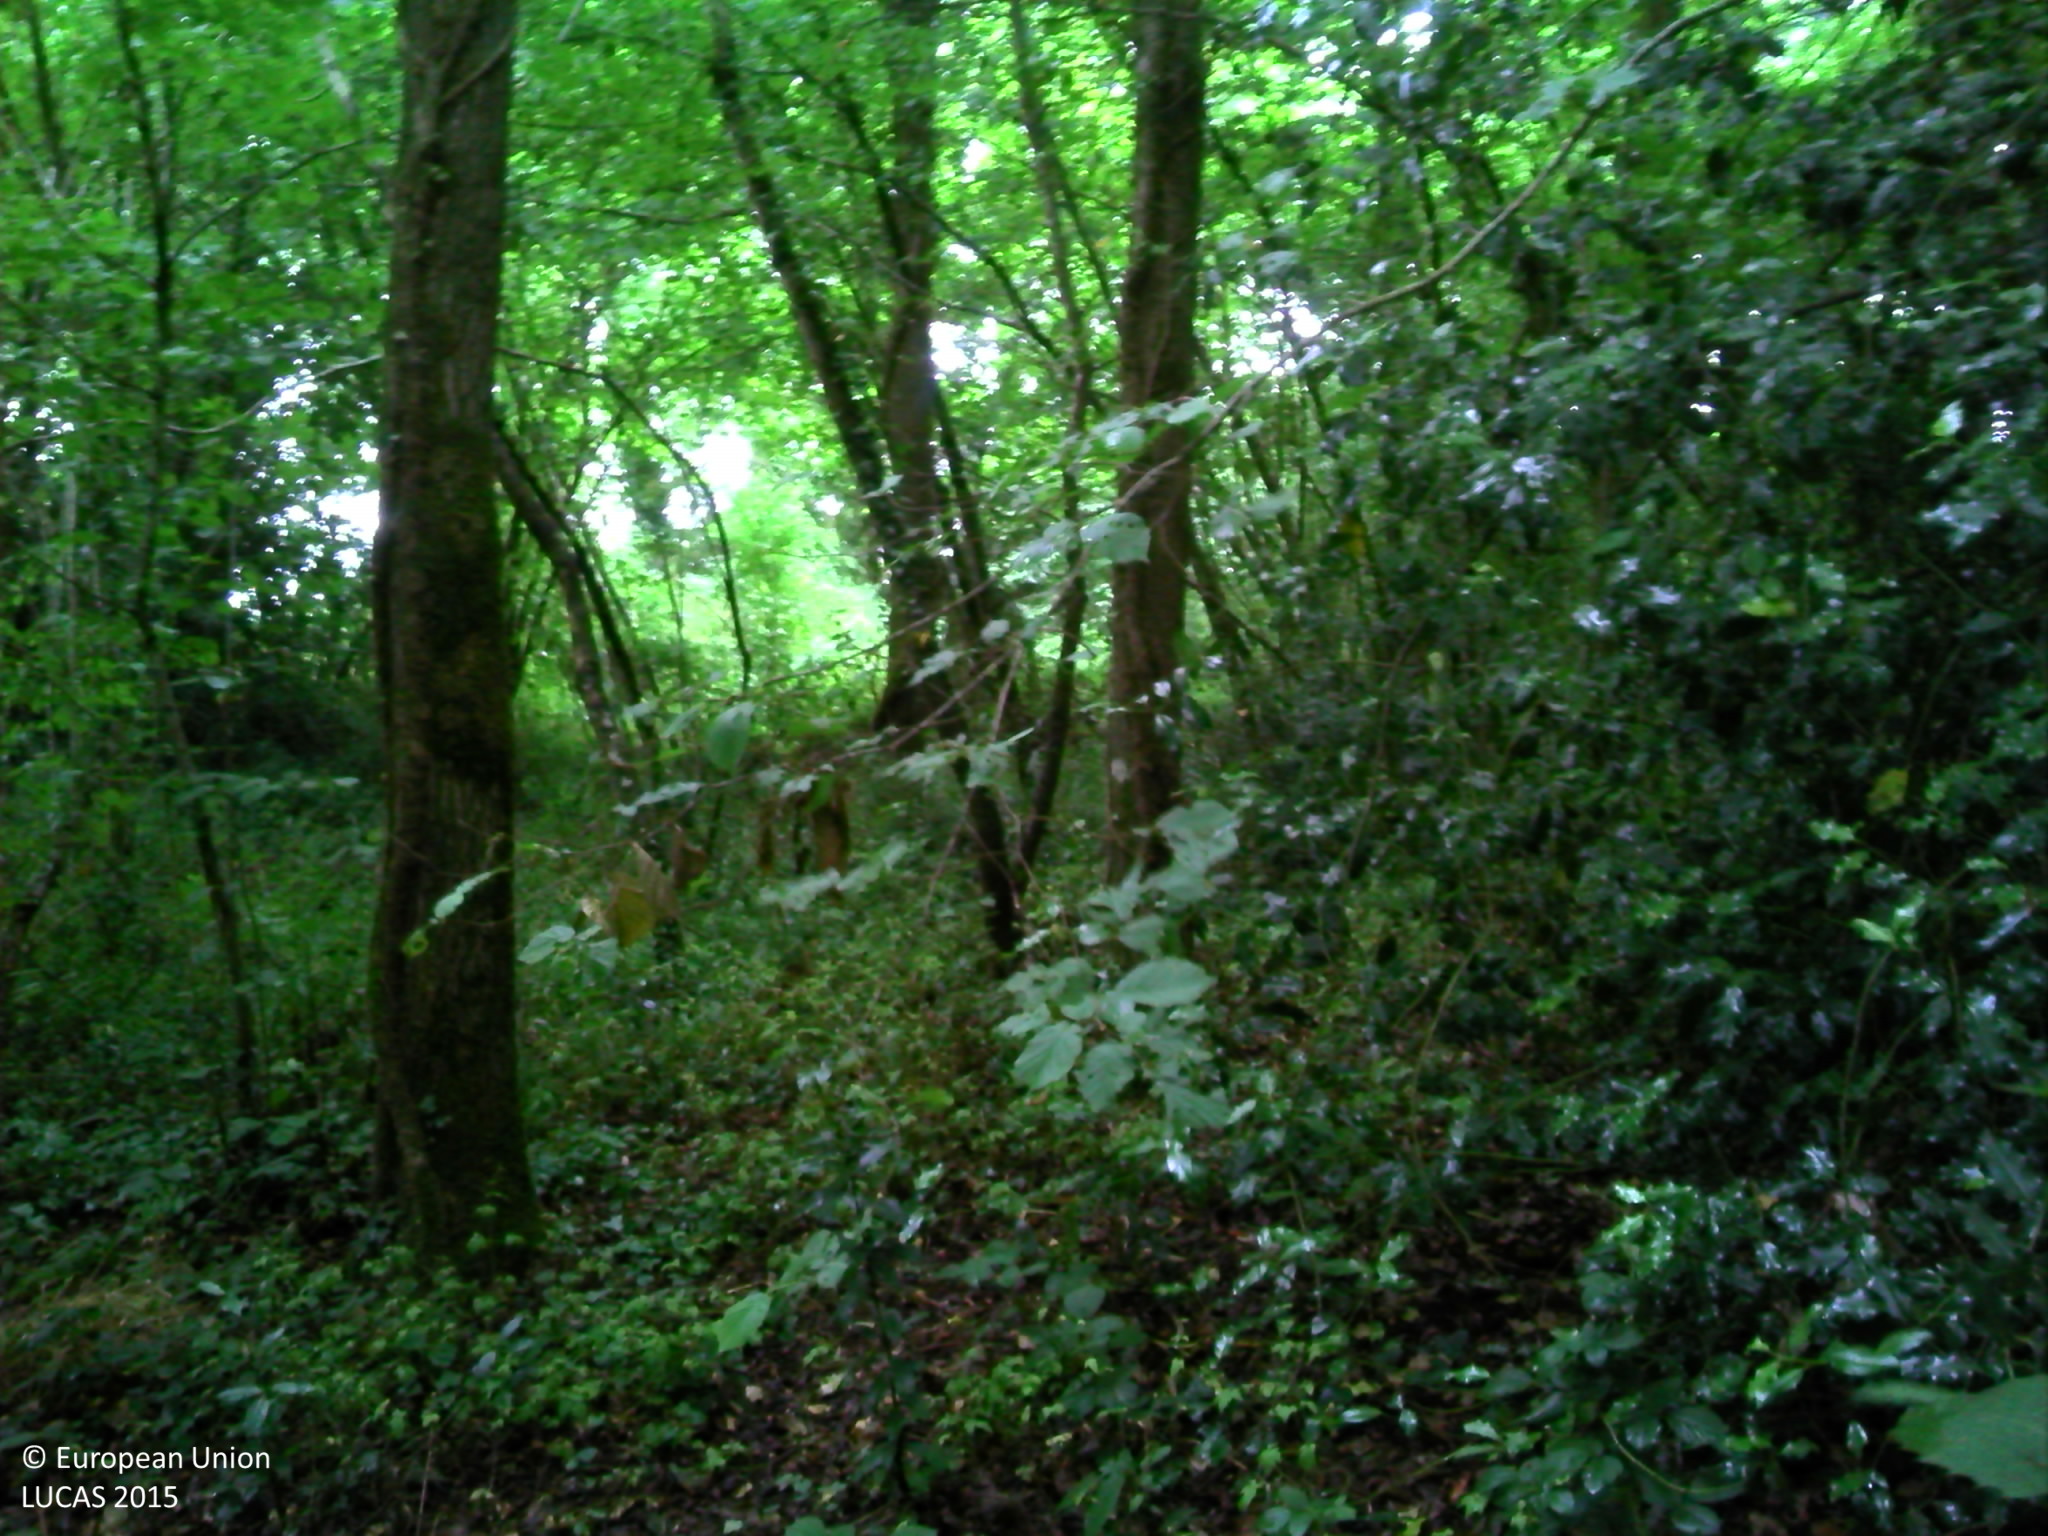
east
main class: Woodland
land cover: Broadleaved woodland
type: non-riverine alder, birch or aspen forest
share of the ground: > 75 %
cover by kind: broadleaved forest trees 95 %, herbaceous plants 5 %
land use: Semi-natural and natural areas not in use
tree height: > 5 m
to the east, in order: Broadleaved woodland; Fences; Maize; Broadleaved woodland; Maize; Managed hedges; Maize
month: July
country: FR
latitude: 47.1782
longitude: -1.8822
